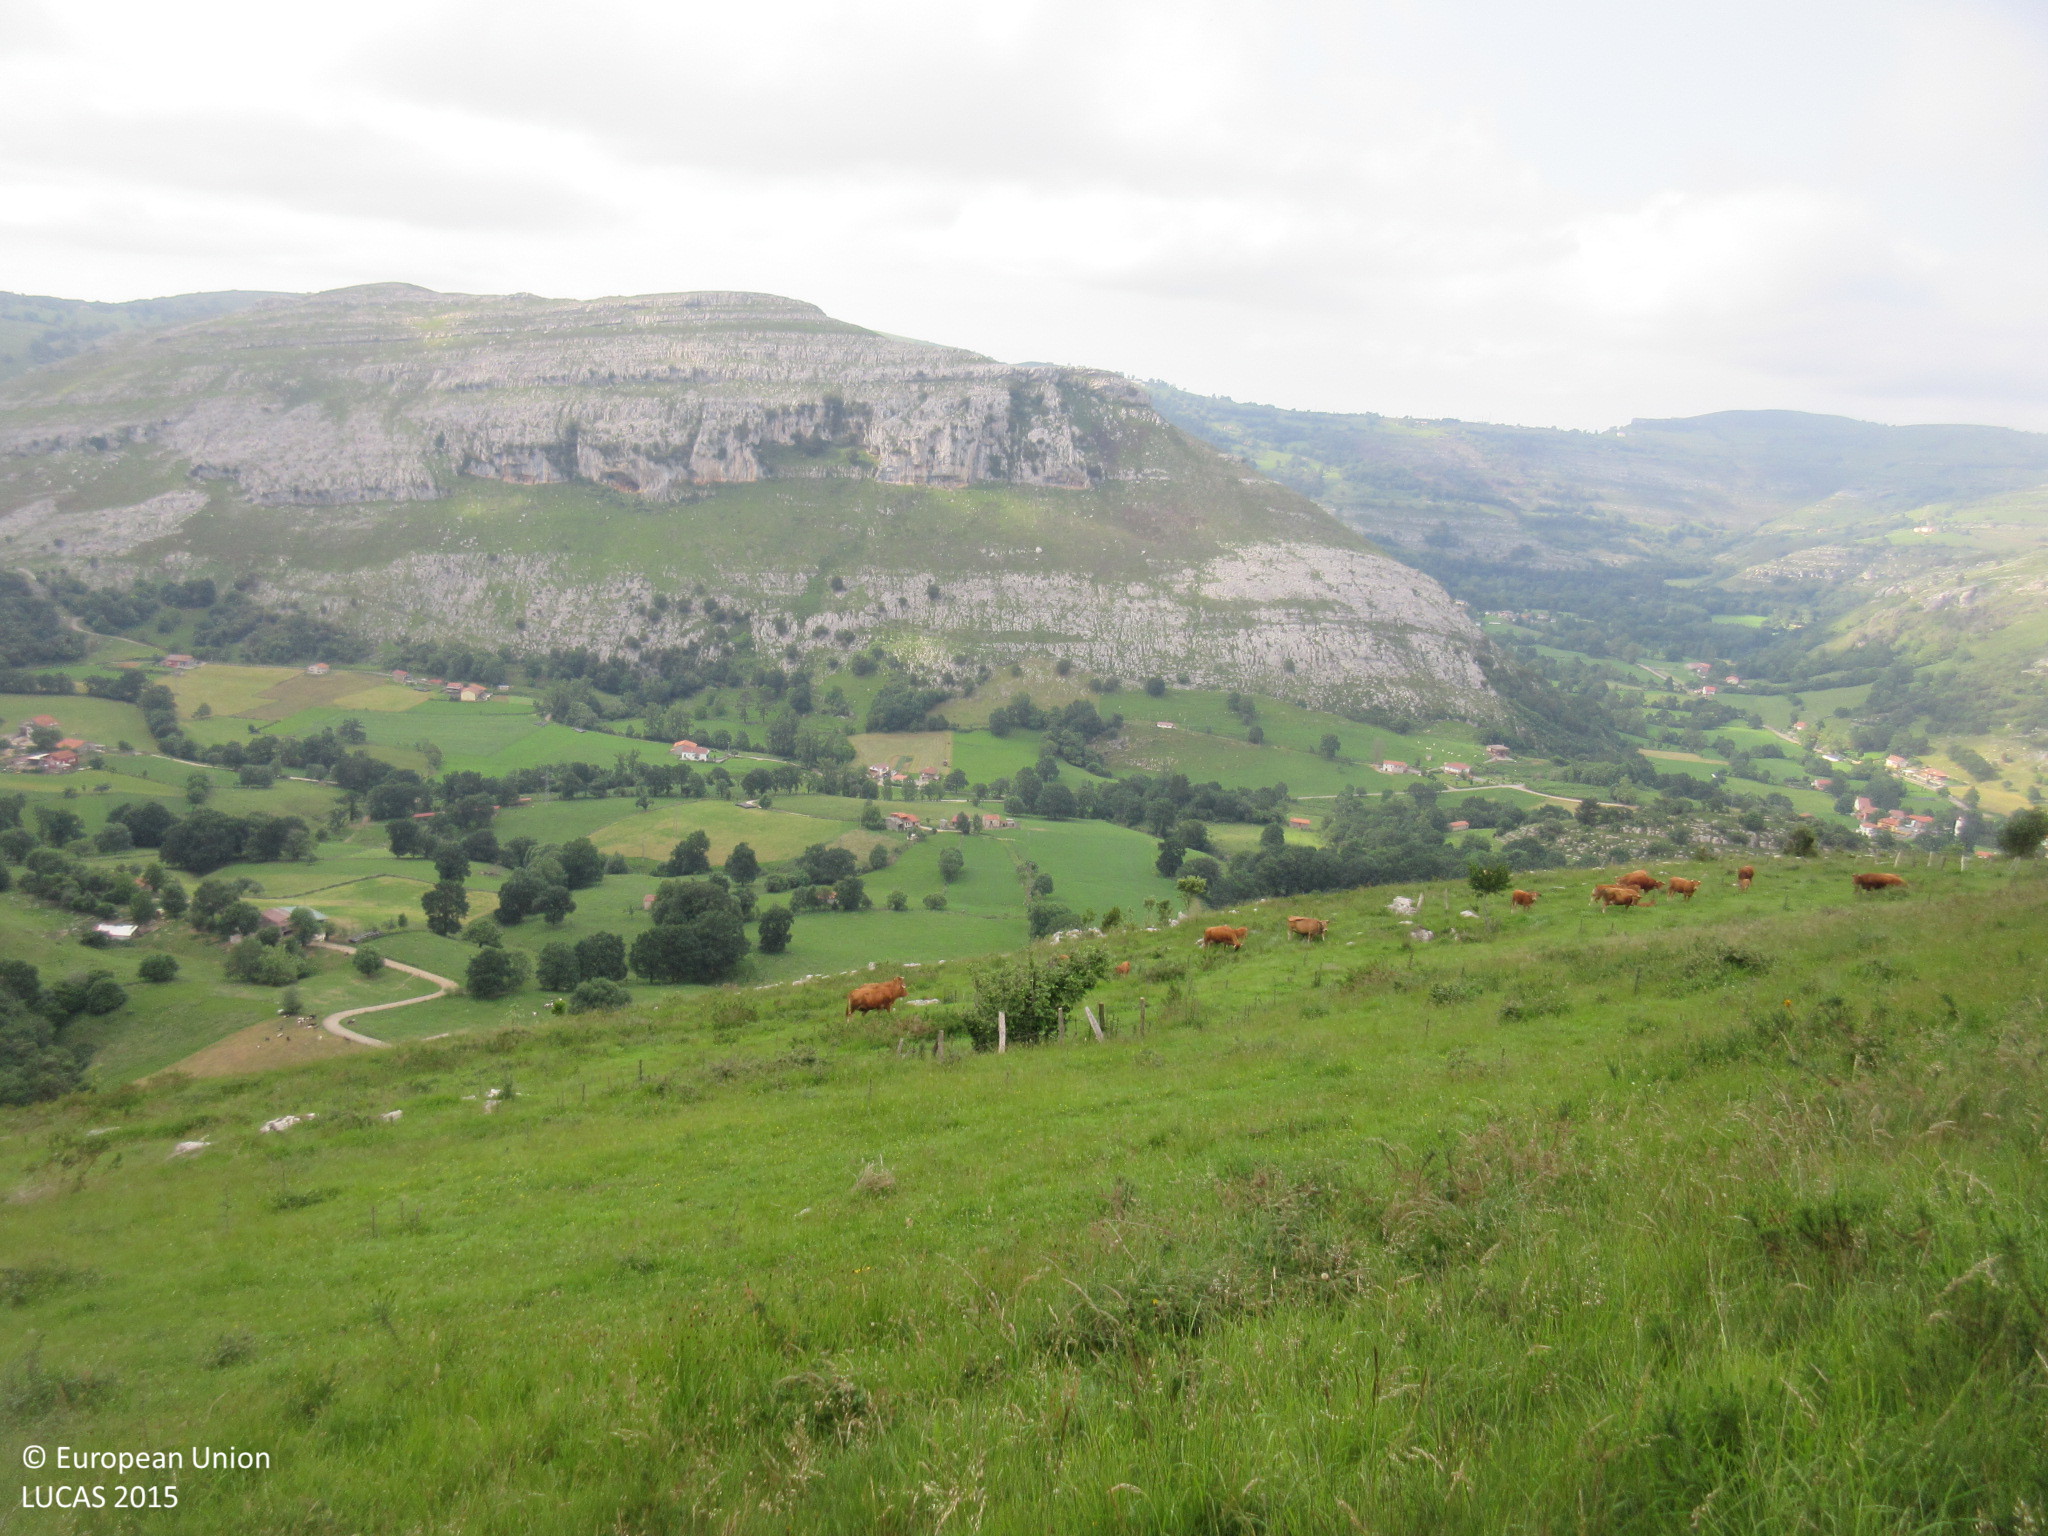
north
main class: Grassland
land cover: Grassland without tree/shrub cover
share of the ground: > 75 %
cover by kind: herbaceous plants 95 %, shrubs 5 %
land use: Agriculture (excluding fallow land and kitchen gardens)
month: June
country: ES
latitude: 43.3052
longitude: -3.5926
